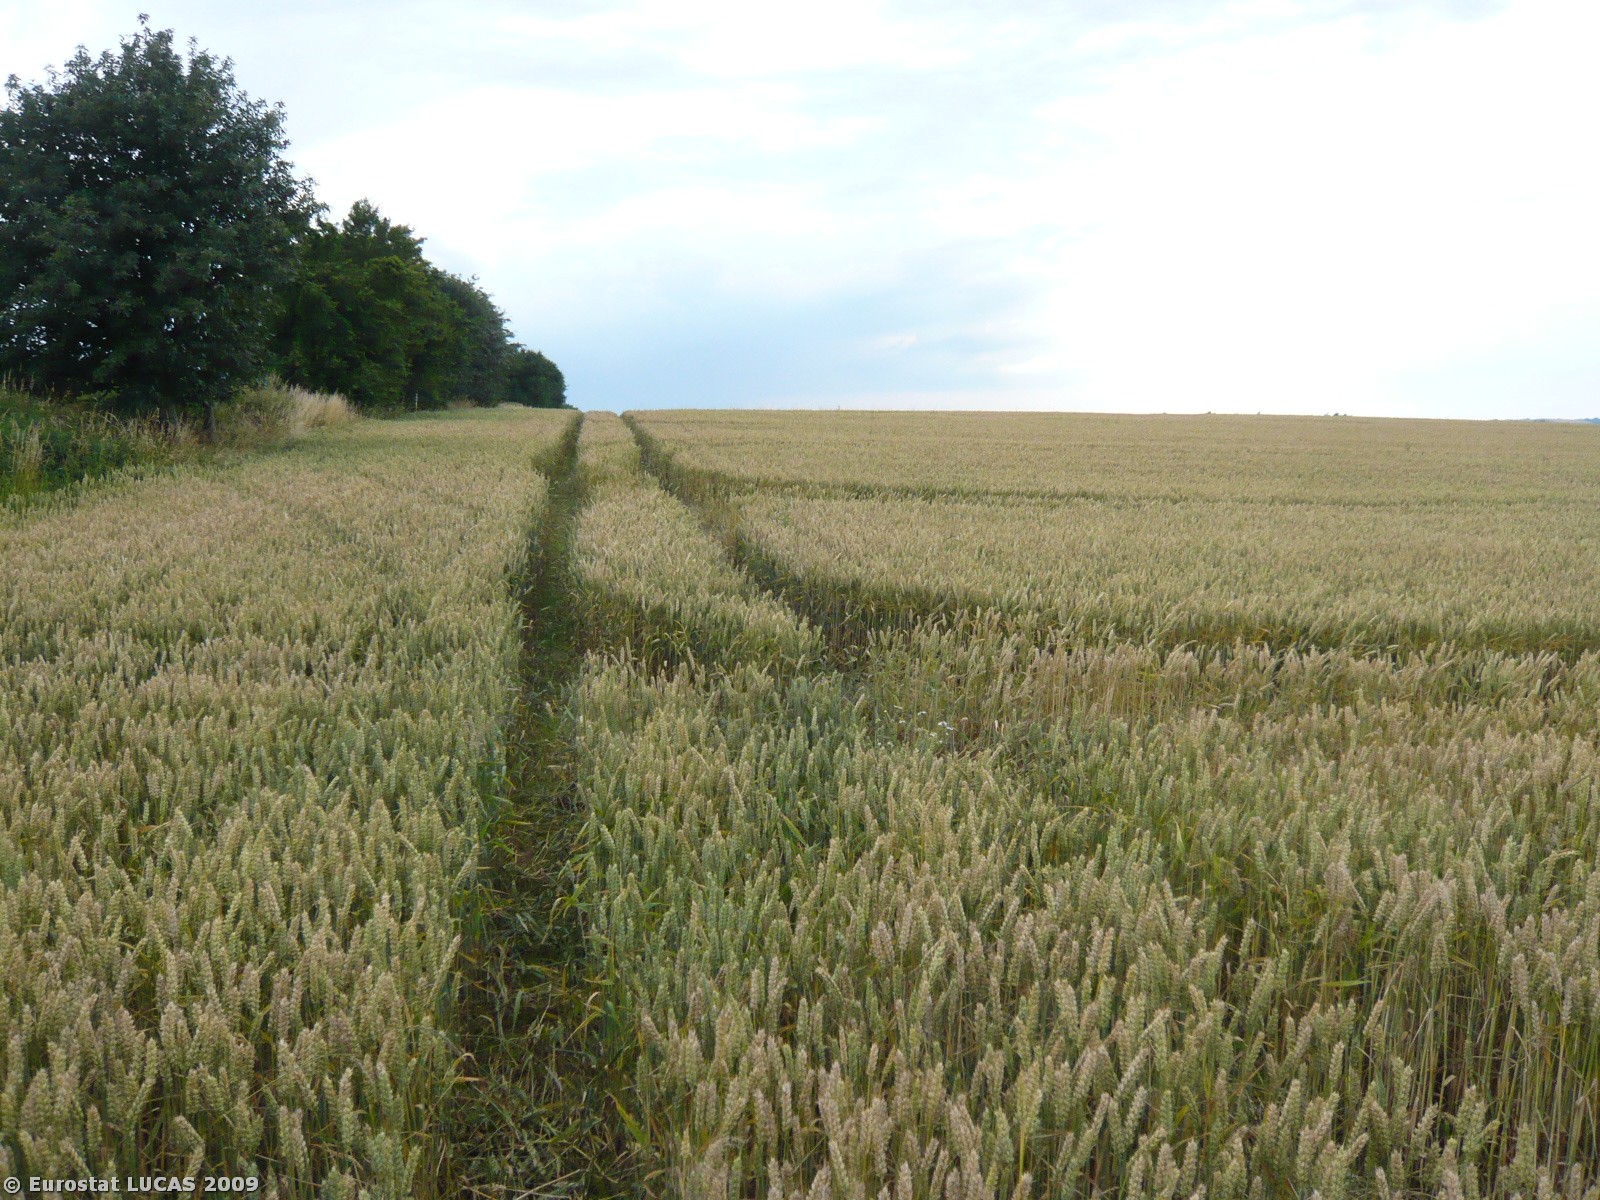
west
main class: Cropland
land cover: Common wheat
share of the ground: > 75 %
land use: Agriculture (excluding fallow land and kitchen gardens)
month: July
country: DK
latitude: 55.7485
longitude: 11.4165
